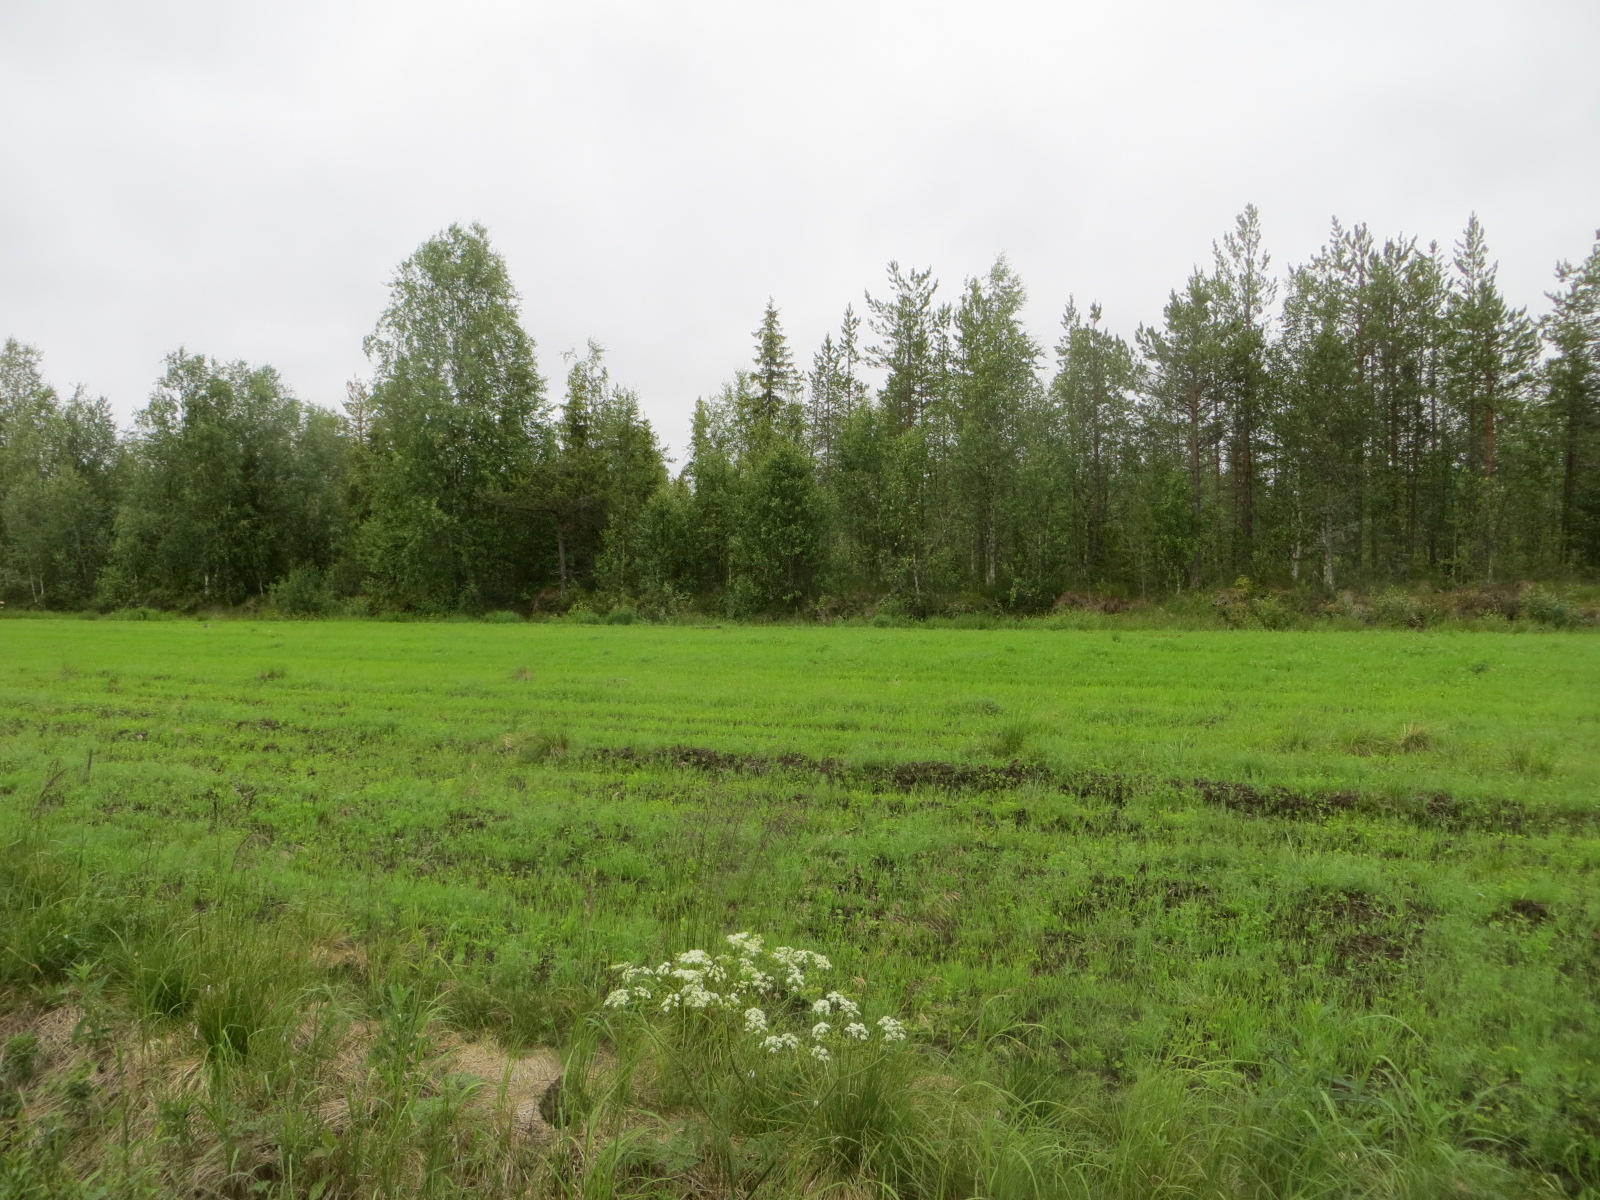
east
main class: Cropland
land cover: Temporary grasslands
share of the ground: 25 - 50 %
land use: Agriculture (excluding fallow land and kitchen gardens)
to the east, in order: Temporary grasslands; Ditches and canals; Temporary grasslands; Ditches and canals; Spruce dominated mixed woodland; Inland fresh running water
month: July
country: FI
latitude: 66.3943
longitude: 24.3892
